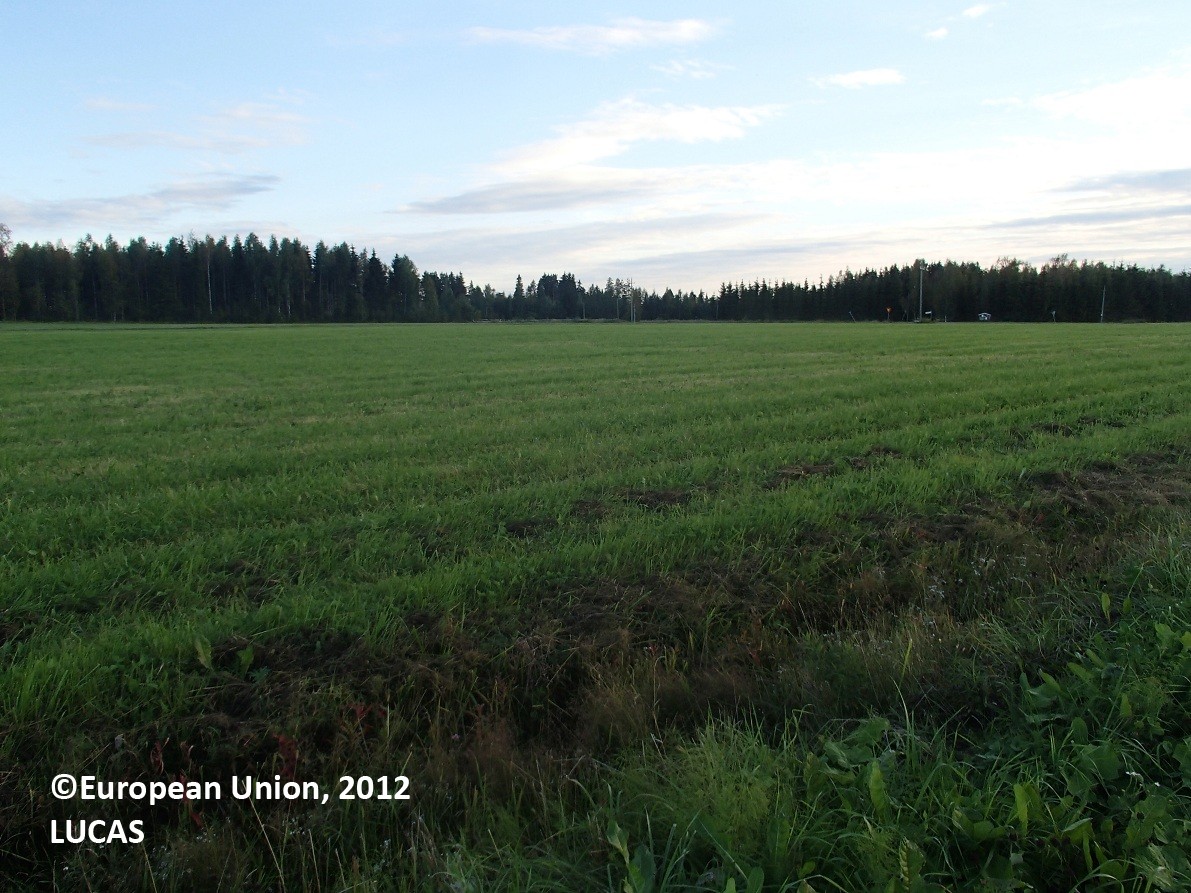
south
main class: Cropland
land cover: Temporary grasslands
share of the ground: > 75 %
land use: Agriculture (excluding fallow land and kitchen gardens)
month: August
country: FI
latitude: 63.5813
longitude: 27.0012
